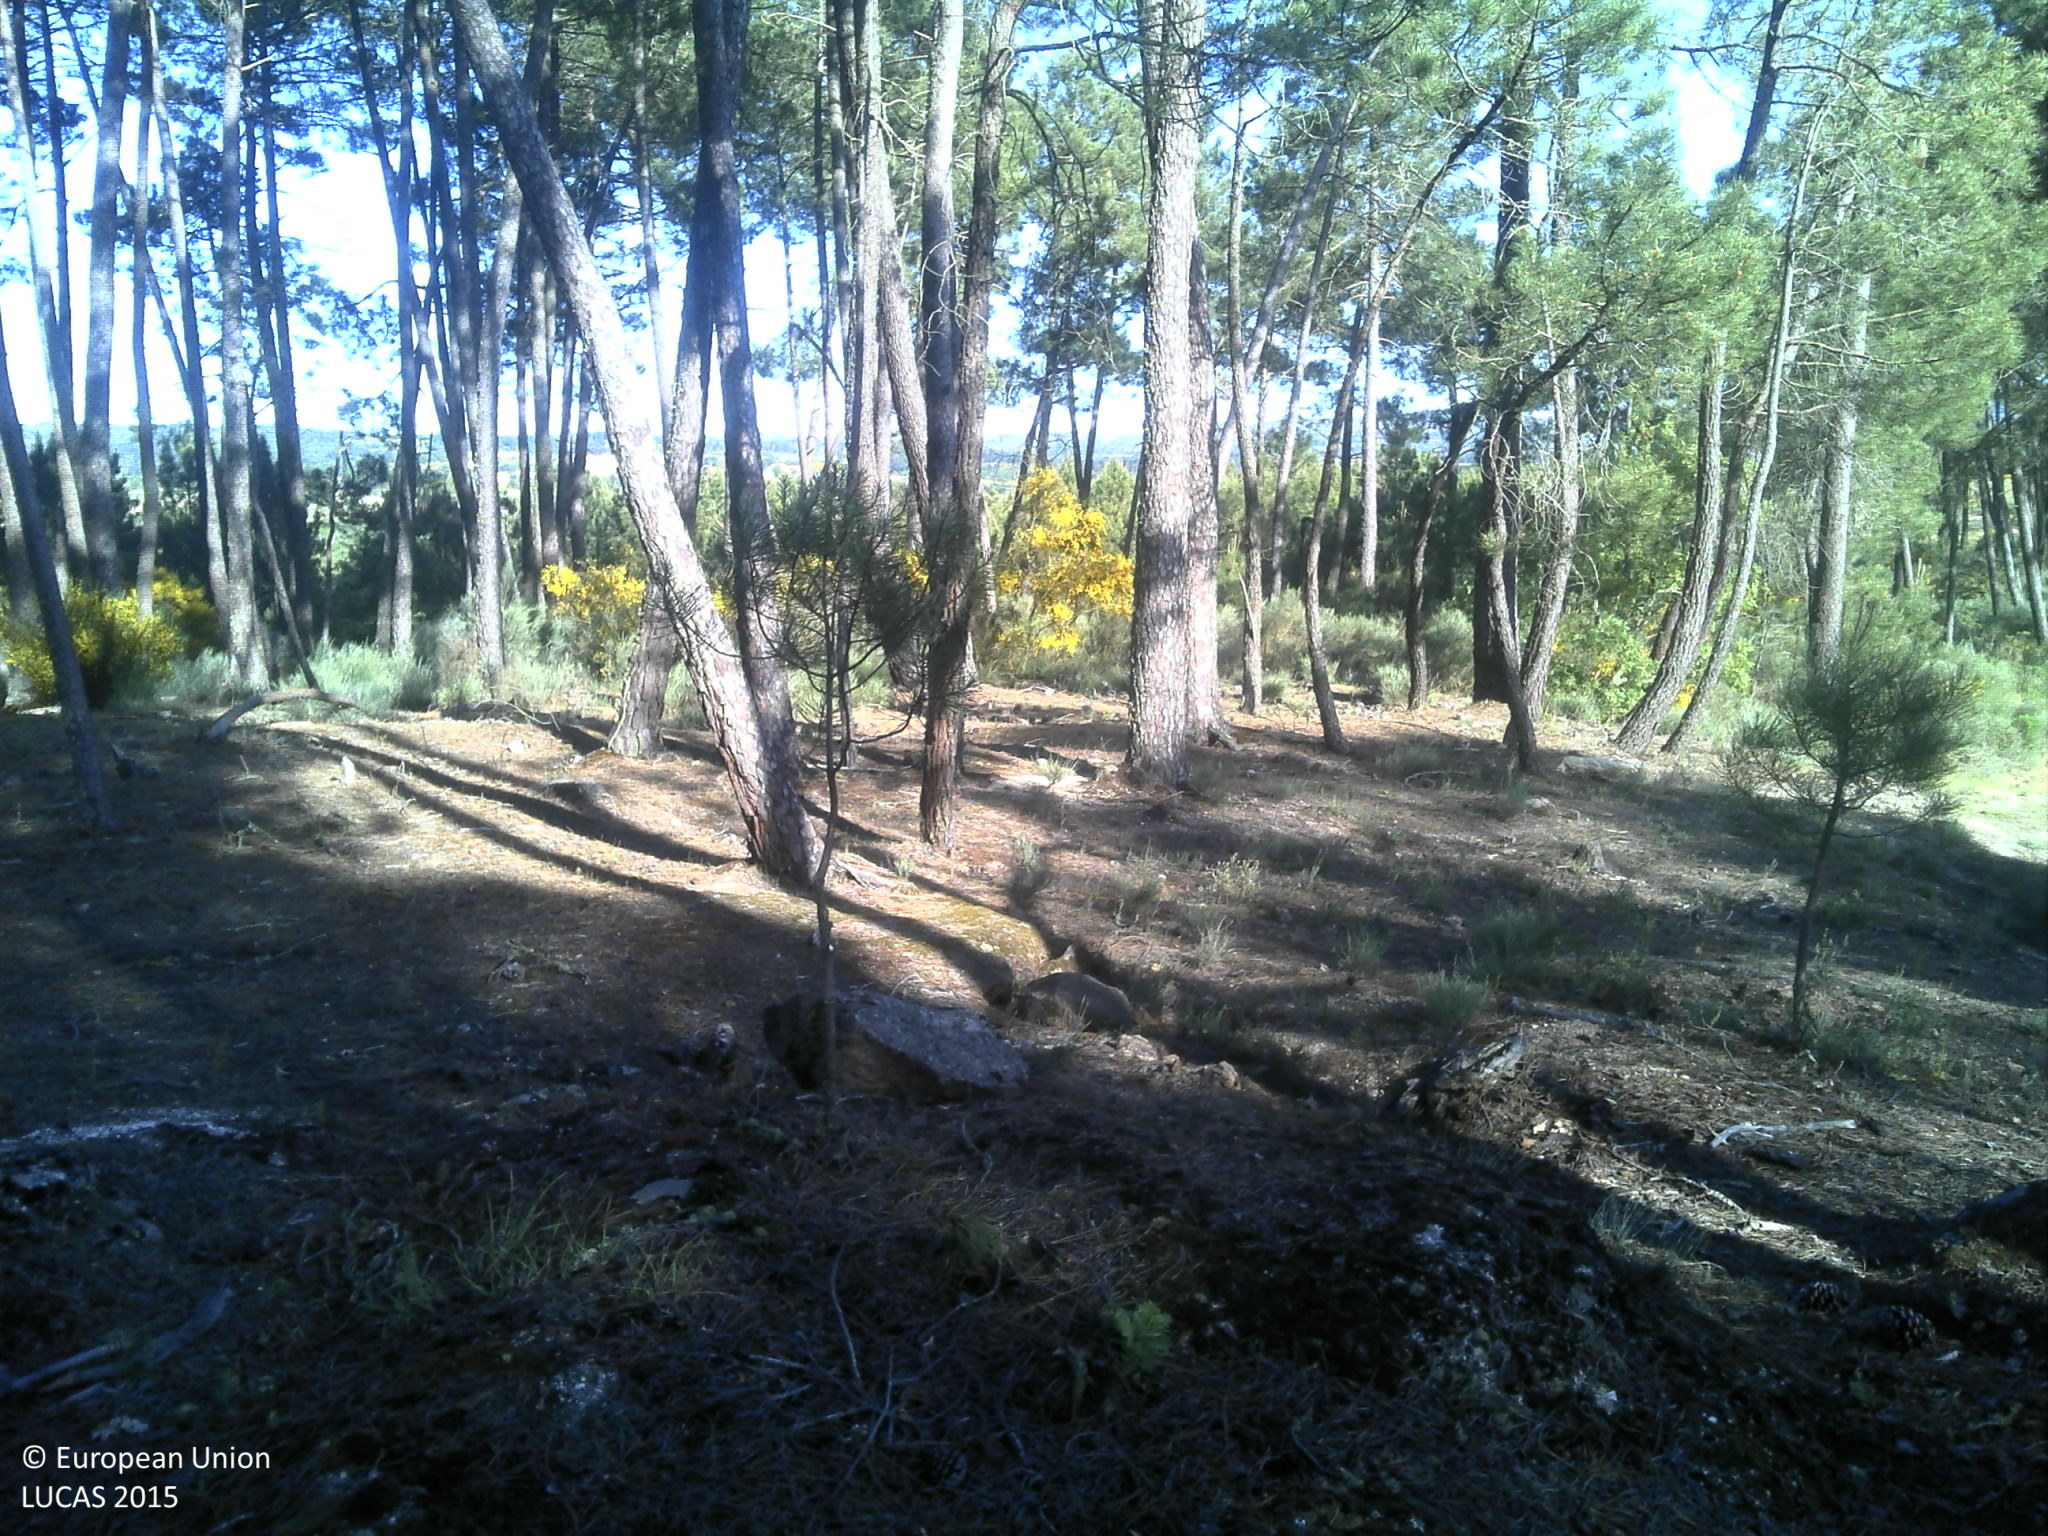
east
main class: Woodland
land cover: Pine dominated coniferous woodland
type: coniferous forest of the mediterranean region
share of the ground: 25 - 50 %
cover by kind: coniferous forest trees 60 %, shrubs 10 %, herbaceous plants 10 %, unconsolidated bare surface 10 %
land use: Forestry
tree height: > 5 m
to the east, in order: Pine dominated coniferous woodland; Tracks; Shrubland with sparse tree cover; Rocks and stones; Shrubland without tree cover; Tracks; Shrubland with sparse tree cover; Abandoned hedges; Spontaneously vegetated surfaces
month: May
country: PT
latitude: 40.7245
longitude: -7.2155
